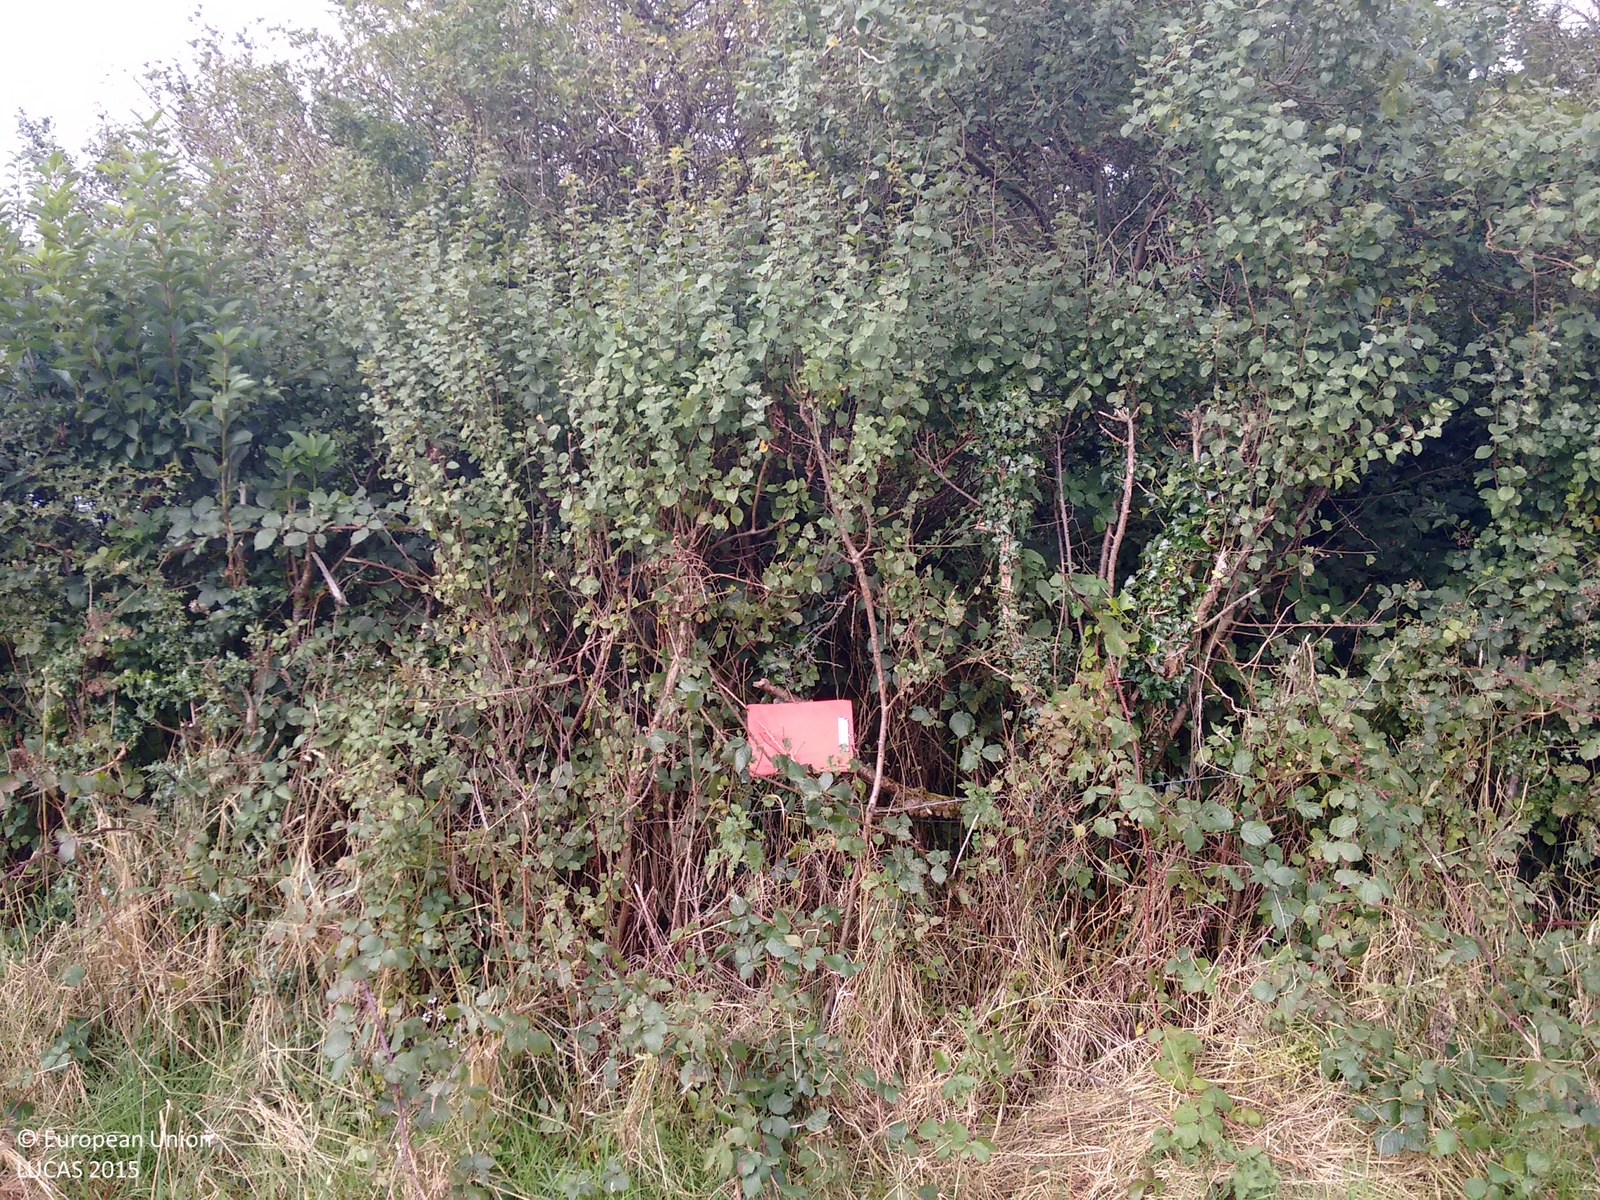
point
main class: Woodland
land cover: Broadleaved woodland
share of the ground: > 75 %
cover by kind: broadleaved forest trees 50 %, herbaceous plants 40 %, shrubs 10 %
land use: Agriculture (excluding fallow land and kitchen gardens)
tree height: < 5 m
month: September
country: IE
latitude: 53.7965
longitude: -9.1494
